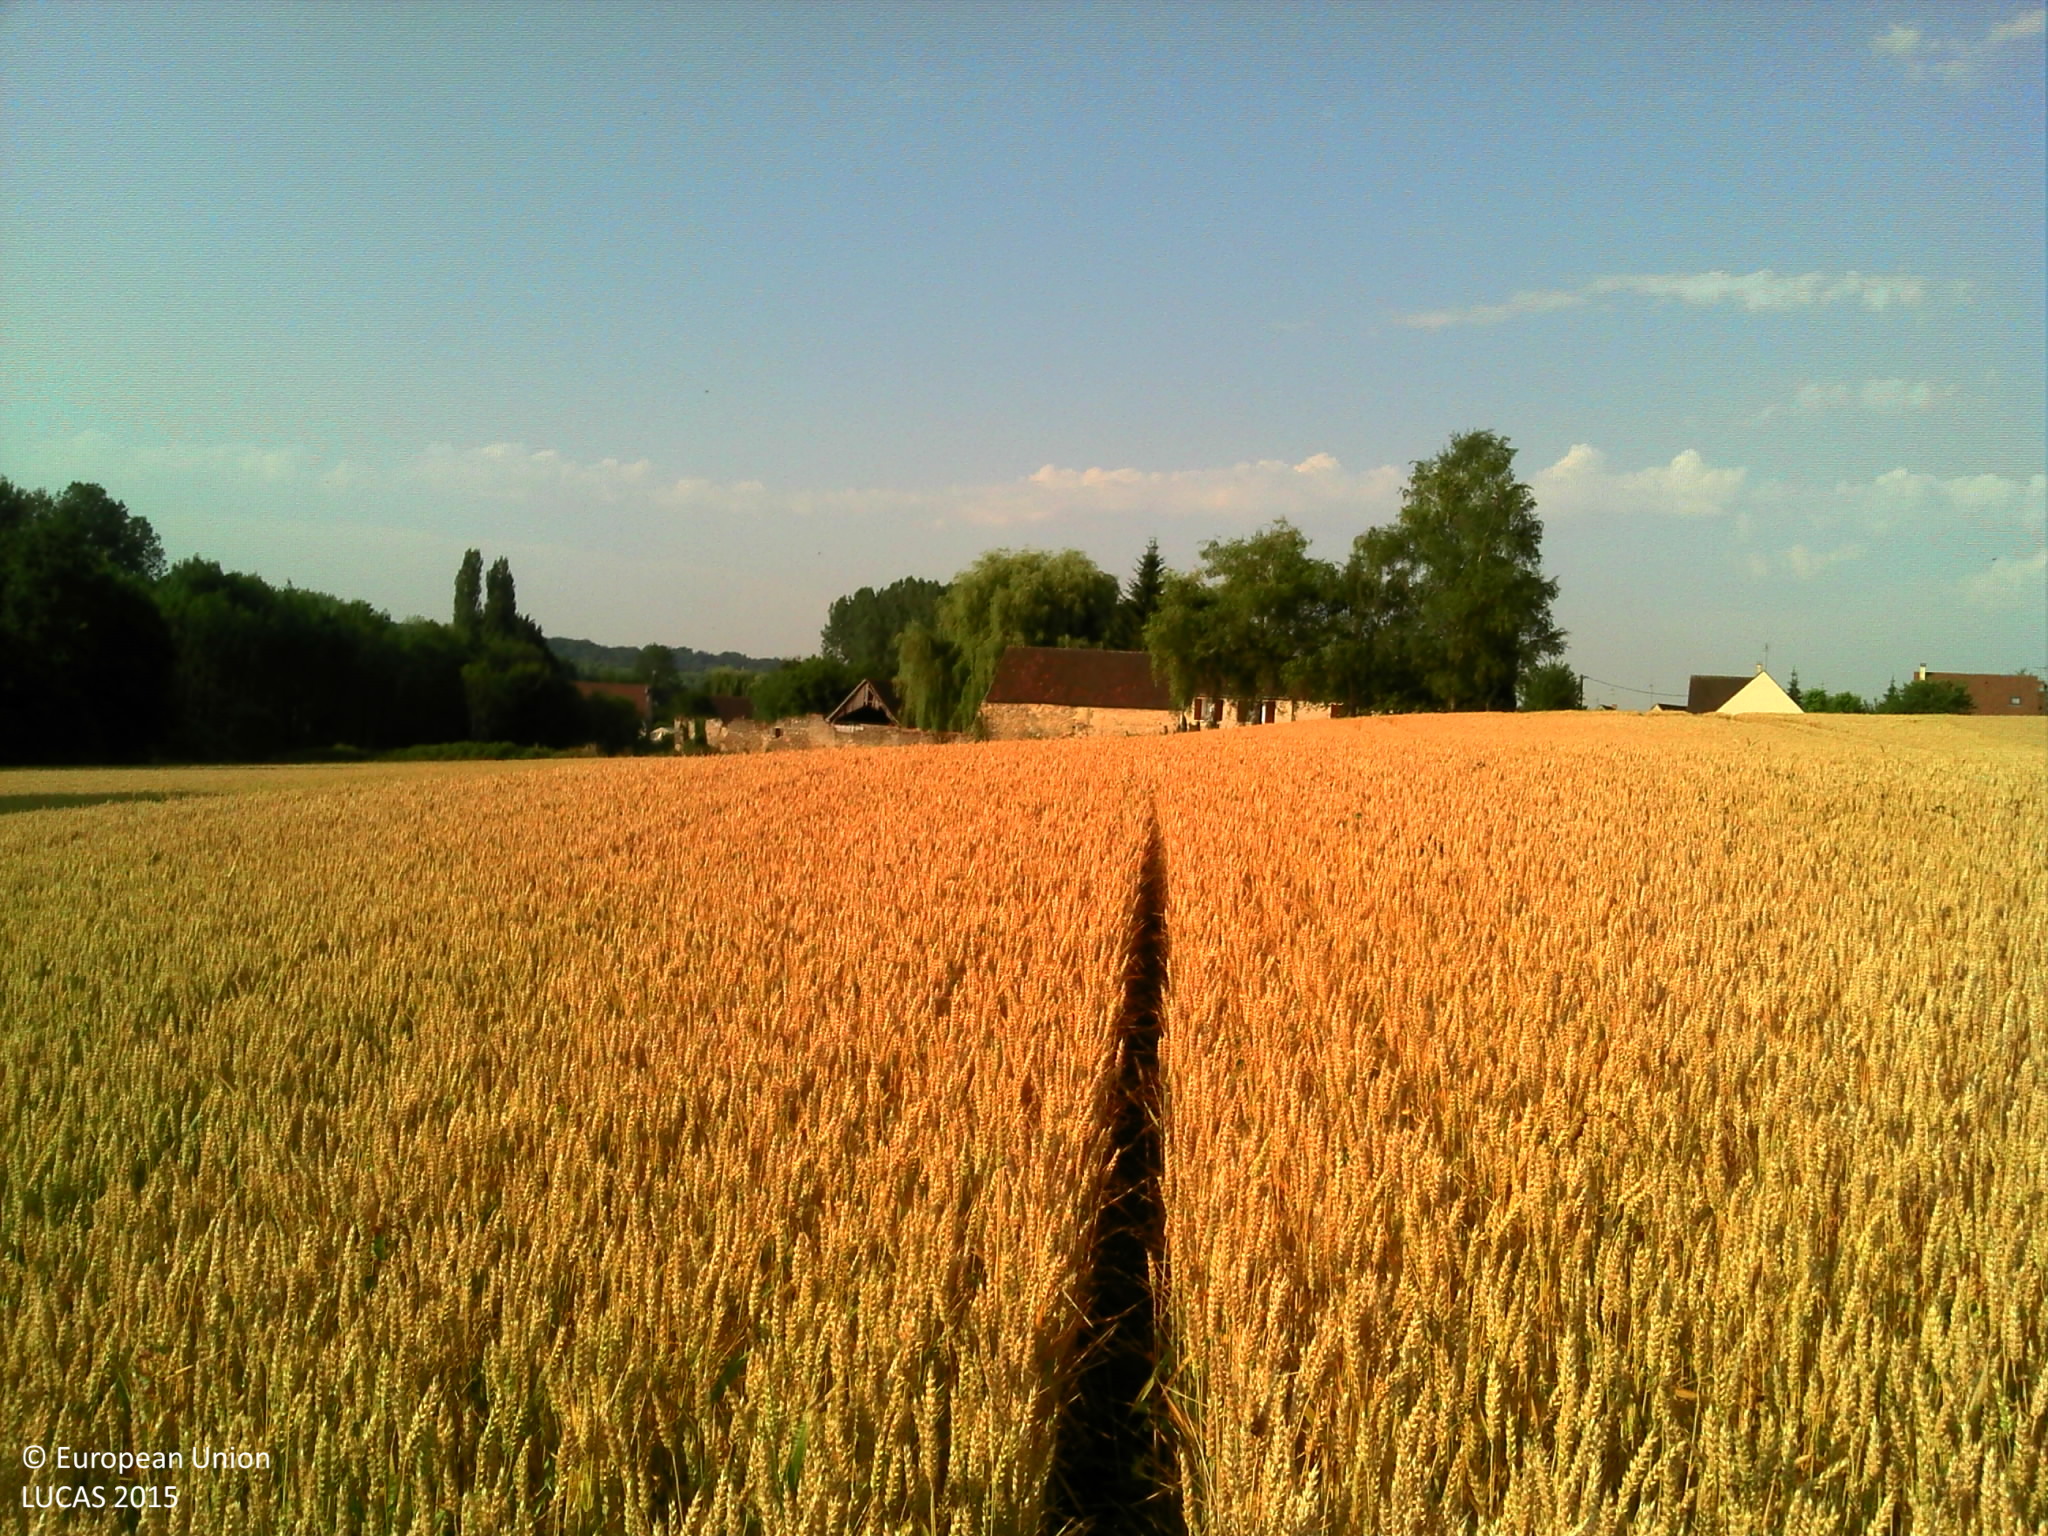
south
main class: Cropland
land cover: Common wheat
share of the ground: > 75 %
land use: Agriculture (excluding fallow land and kitchen gardens)
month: July
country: FR
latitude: 49.3080
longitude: 2.5475
